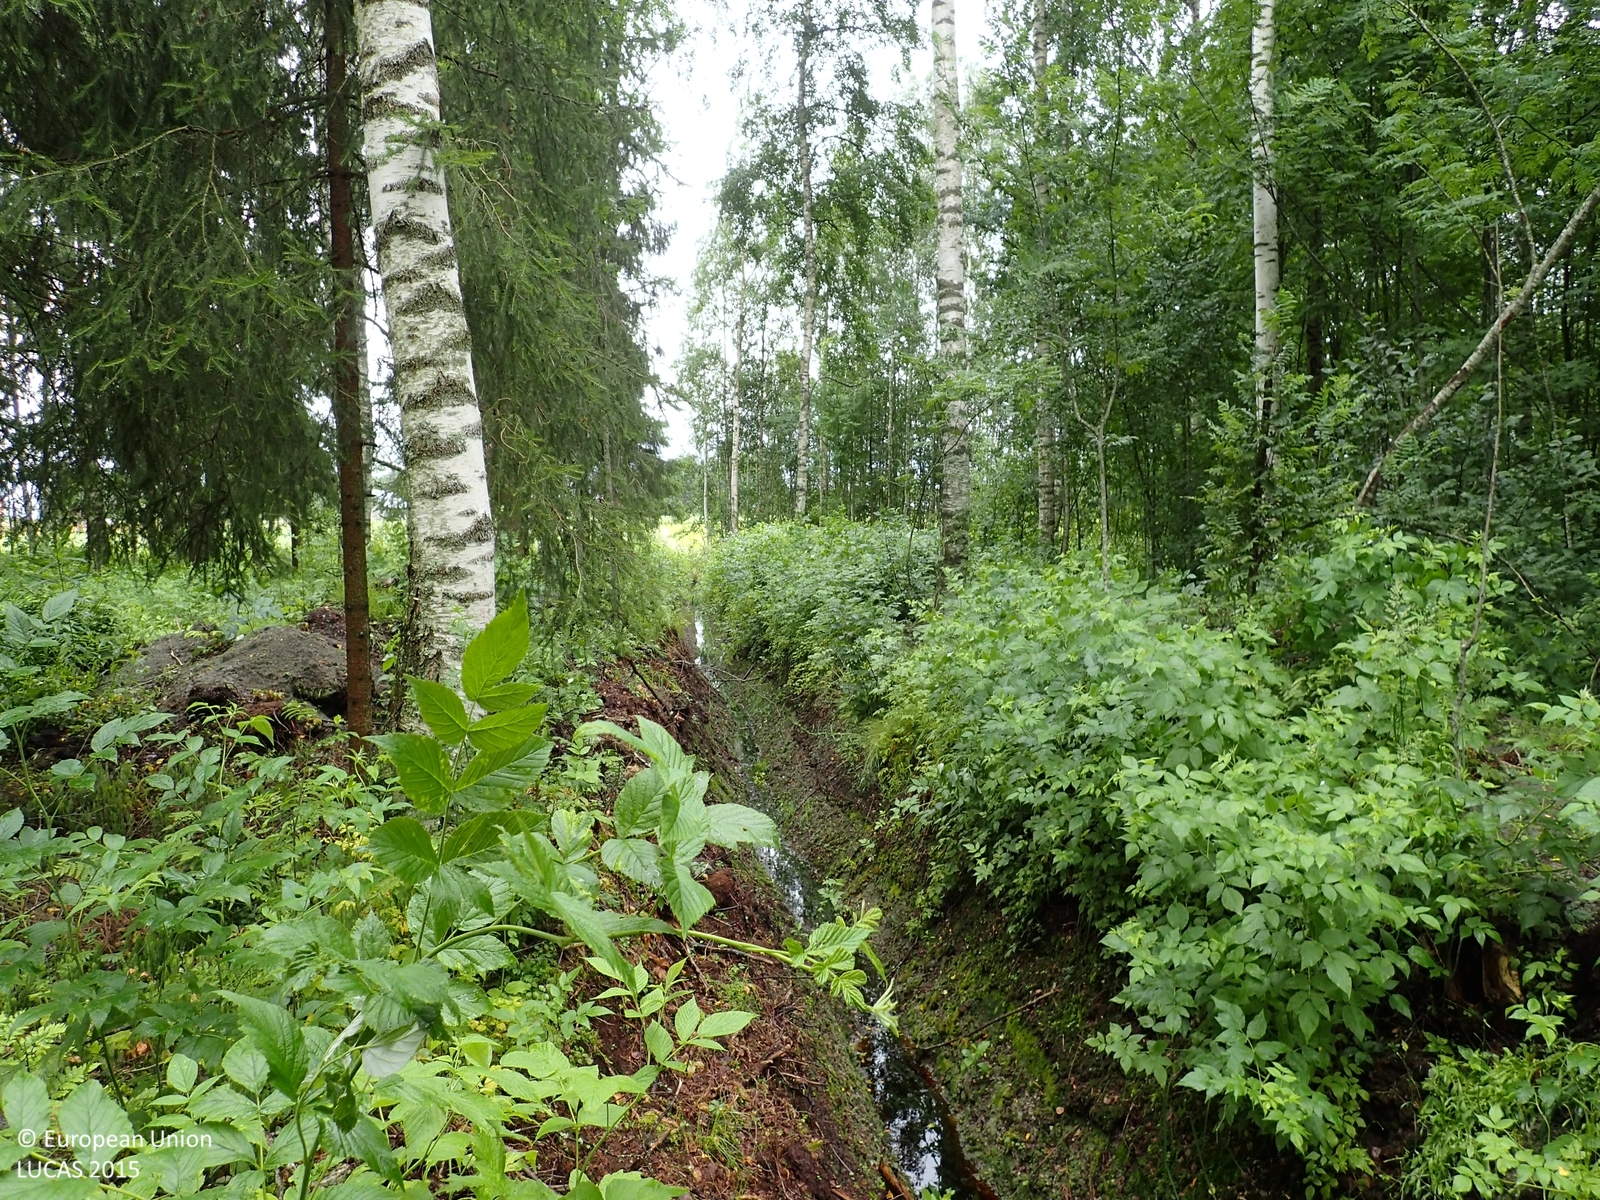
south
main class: Woodland
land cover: Other mixed woodland
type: boreal forest
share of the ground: 50 - 75 %
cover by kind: coniferous forest trees 45 %, herbaceous plants 40 %, broadleaved forest trees 15 %
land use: Forestry
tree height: > 5 m
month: July
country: FI
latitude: 62.9067
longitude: 22.7900
